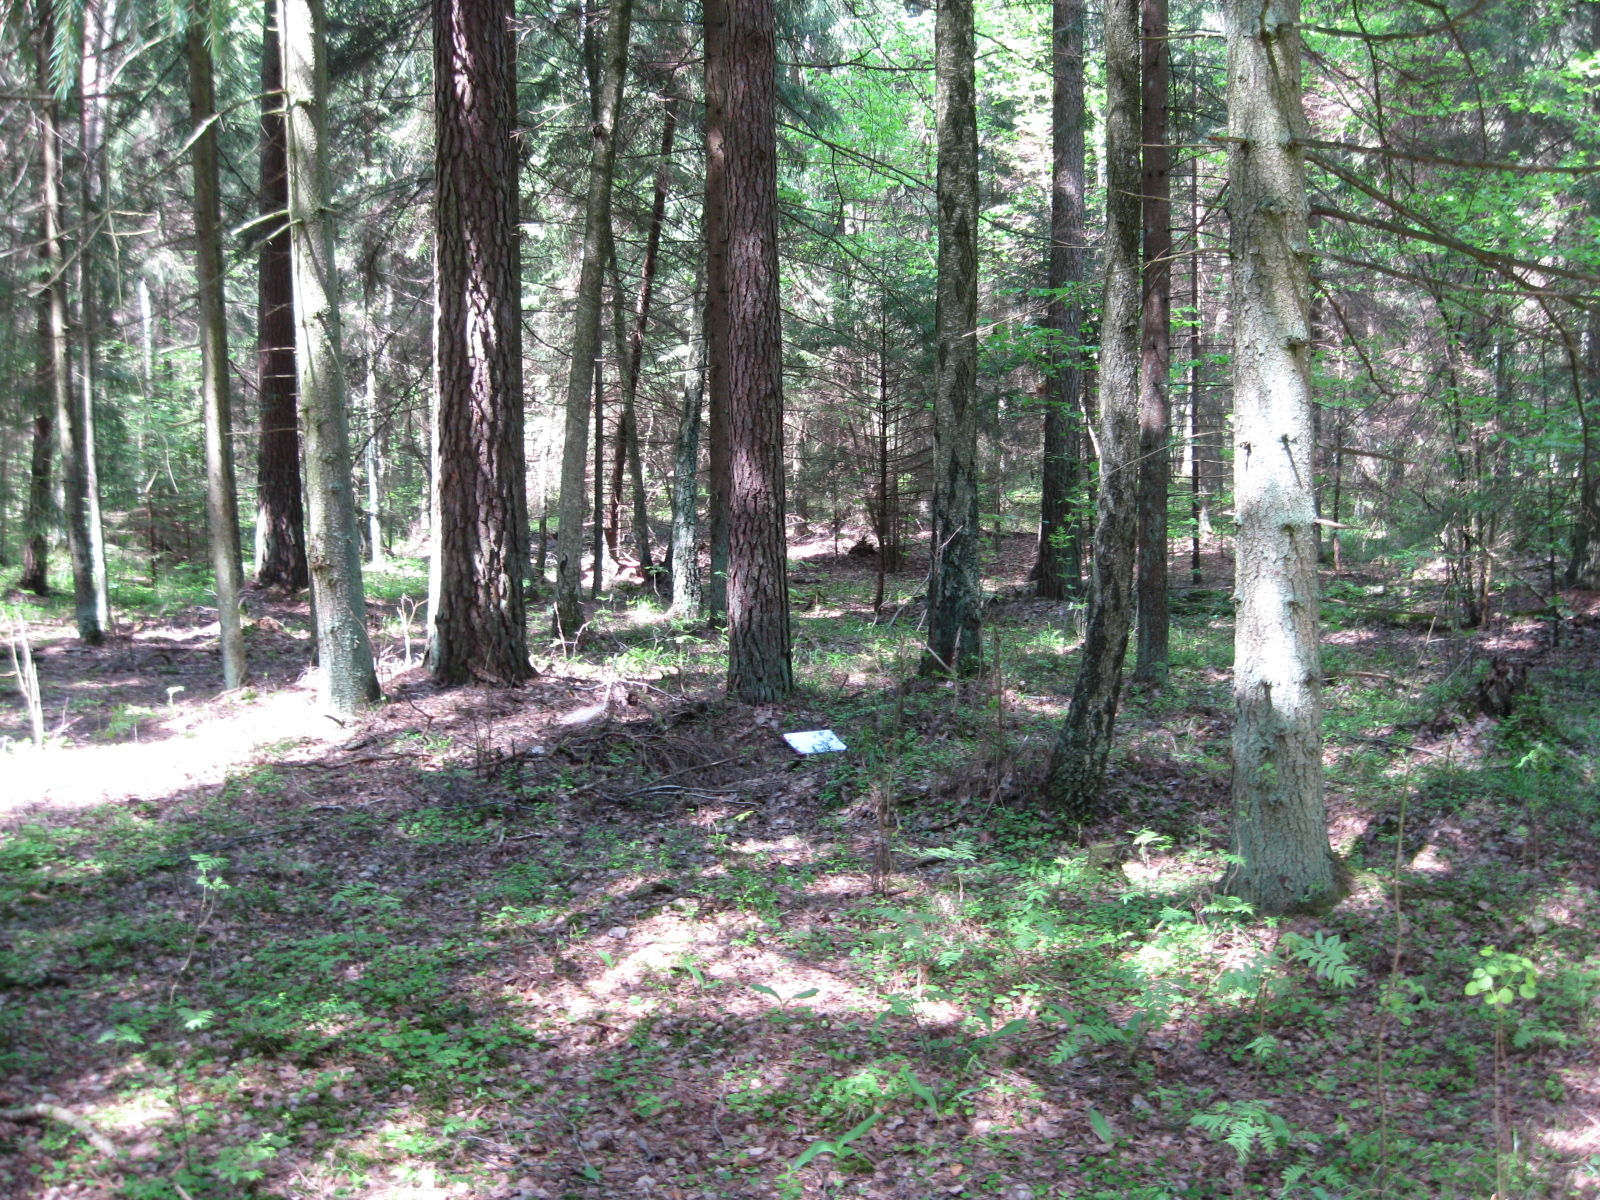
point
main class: Woodland
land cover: Spruce dominated mixed woodland
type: hemiboreal forest and nemoral coniferous forest and mixed broadleaved-coniferous forest
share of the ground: > 75 %
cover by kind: coniferous forest trees 50 %, broadleaved forest trees 45 %, lichens and mosses 5 %
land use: Forestry
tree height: > 5 m
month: May
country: LT
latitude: 56.0047
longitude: 24.1219
